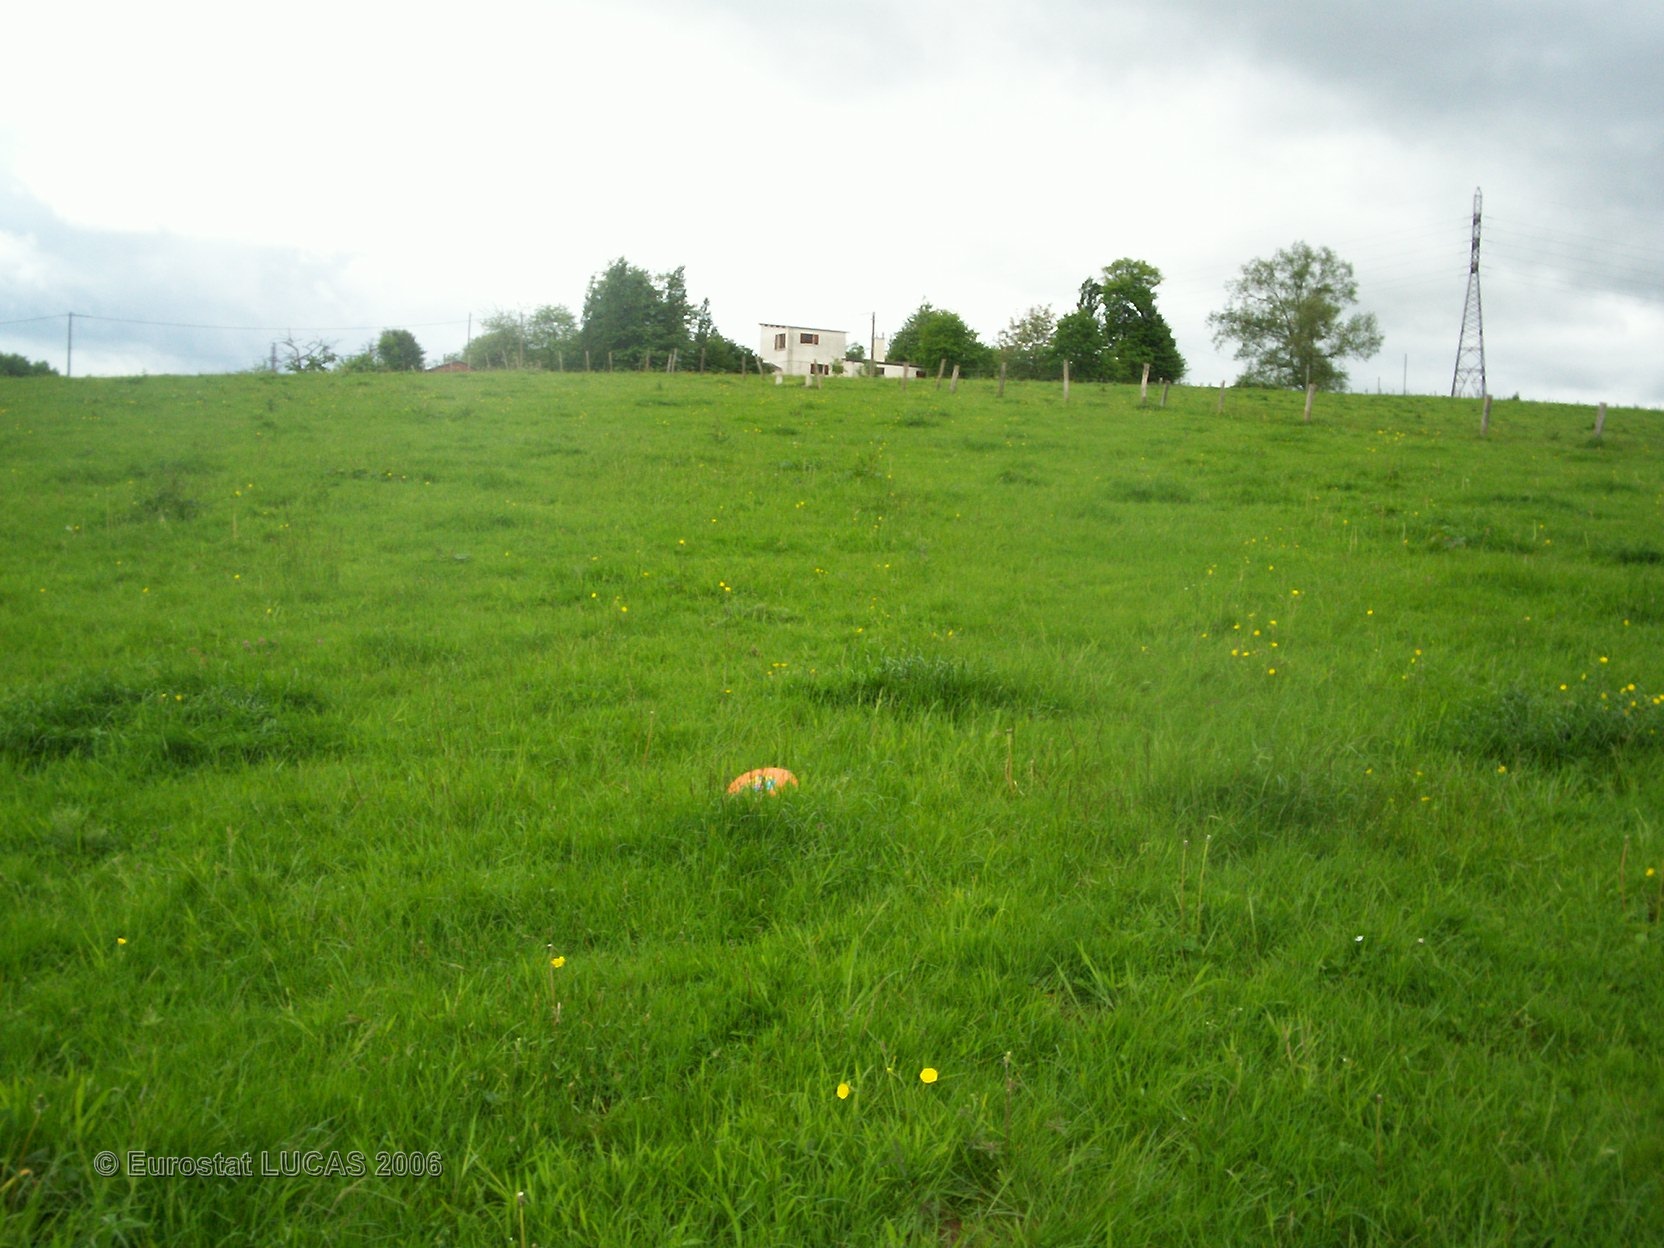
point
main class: Grassland
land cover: Grassland without tree/shrub cover
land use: Agriculture (excluding fallow land and kitchen gardens)
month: May
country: FR
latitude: 49.5138
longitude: 0.4844
